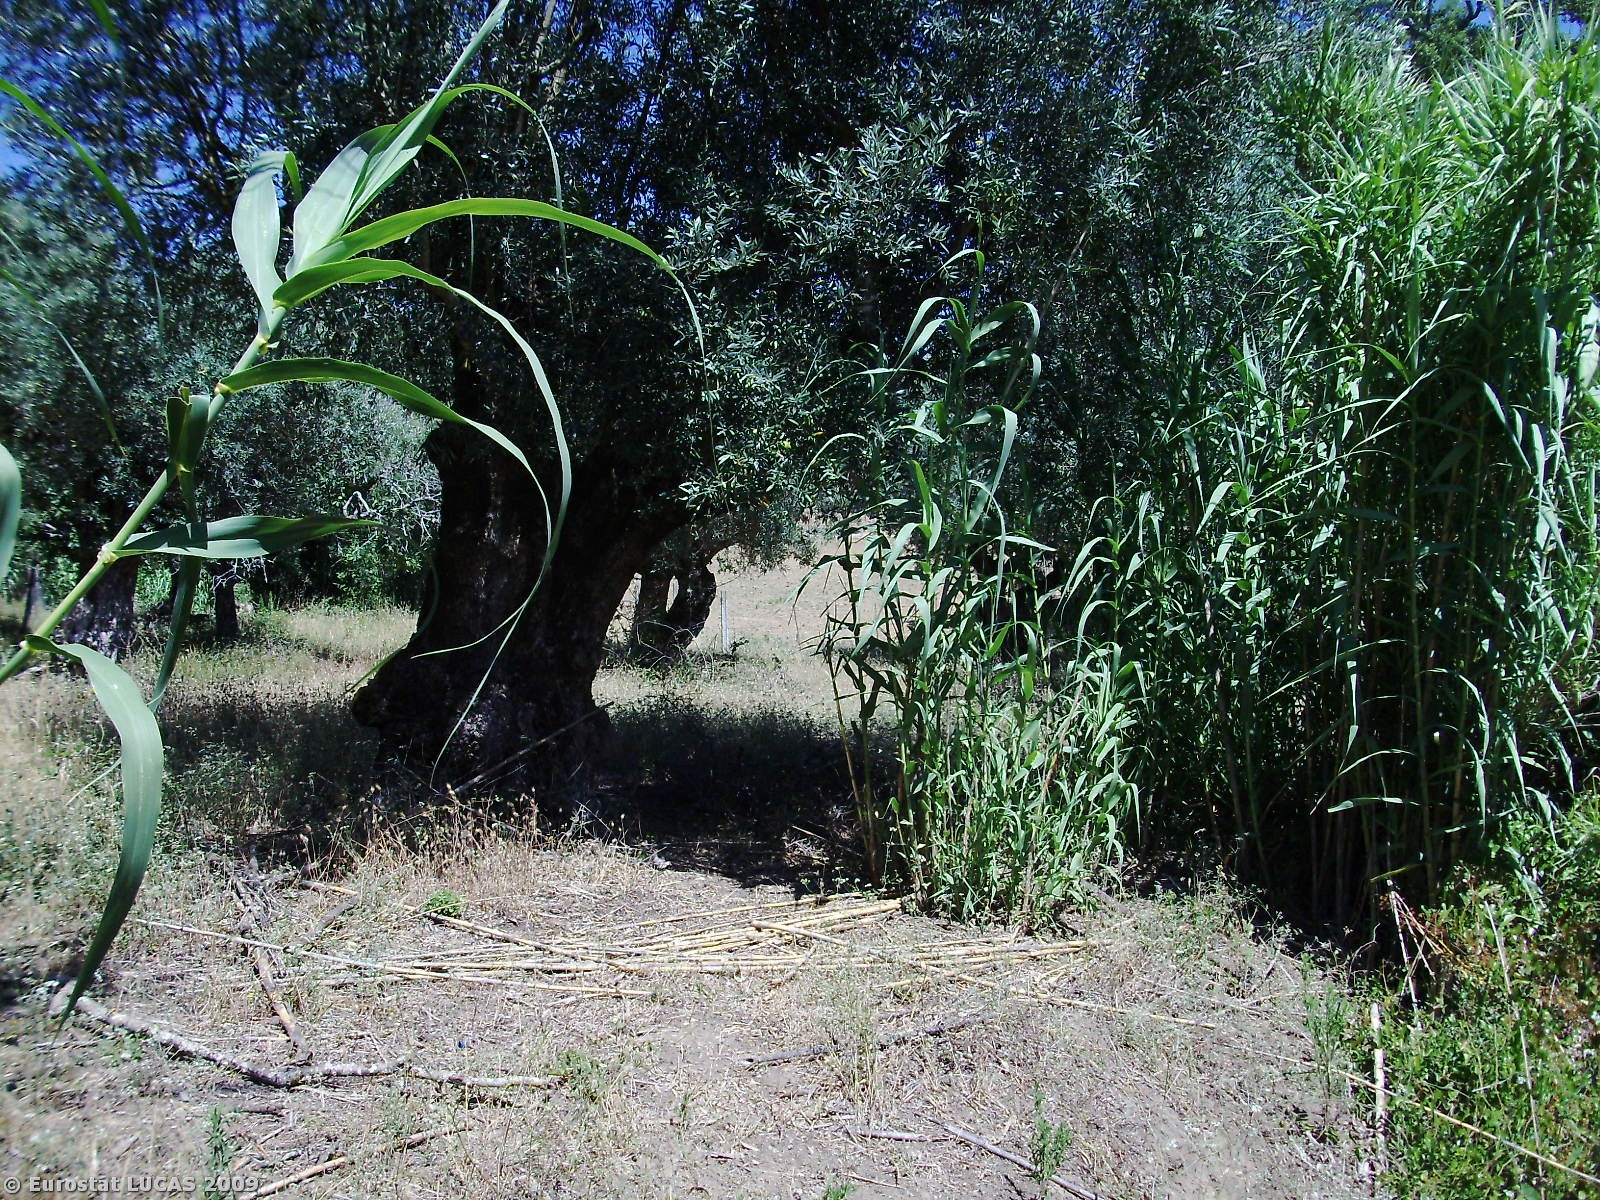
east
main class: Cropland
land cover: Olive groves
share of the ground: 10 - 25 %
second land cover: Spontaneously vegetated surfaces
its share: 50 - 75 %
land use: Agriculture (excluding fallow land and kitchen gardens)
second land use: Fallow land
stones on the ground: 10 - 25 %
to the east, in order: Olive groves; Spontaneously vegetated surfaces; Olive groves; Ditches and canals; Olive groves; Spontaneously vegetated surfaces; Fences; Bare land; Olive groves; Fences; Bare land; Olive groves; Fences; Bare land; Olive groves; Artificial constructions in urban areas; Electric lines; Tracks; Fences; Grassland without tree/shrub cover; Electric lines; Fences; Paved roads, cycling and walking lanes
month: July
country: PT
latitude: 39.4321
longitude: -8.7956
